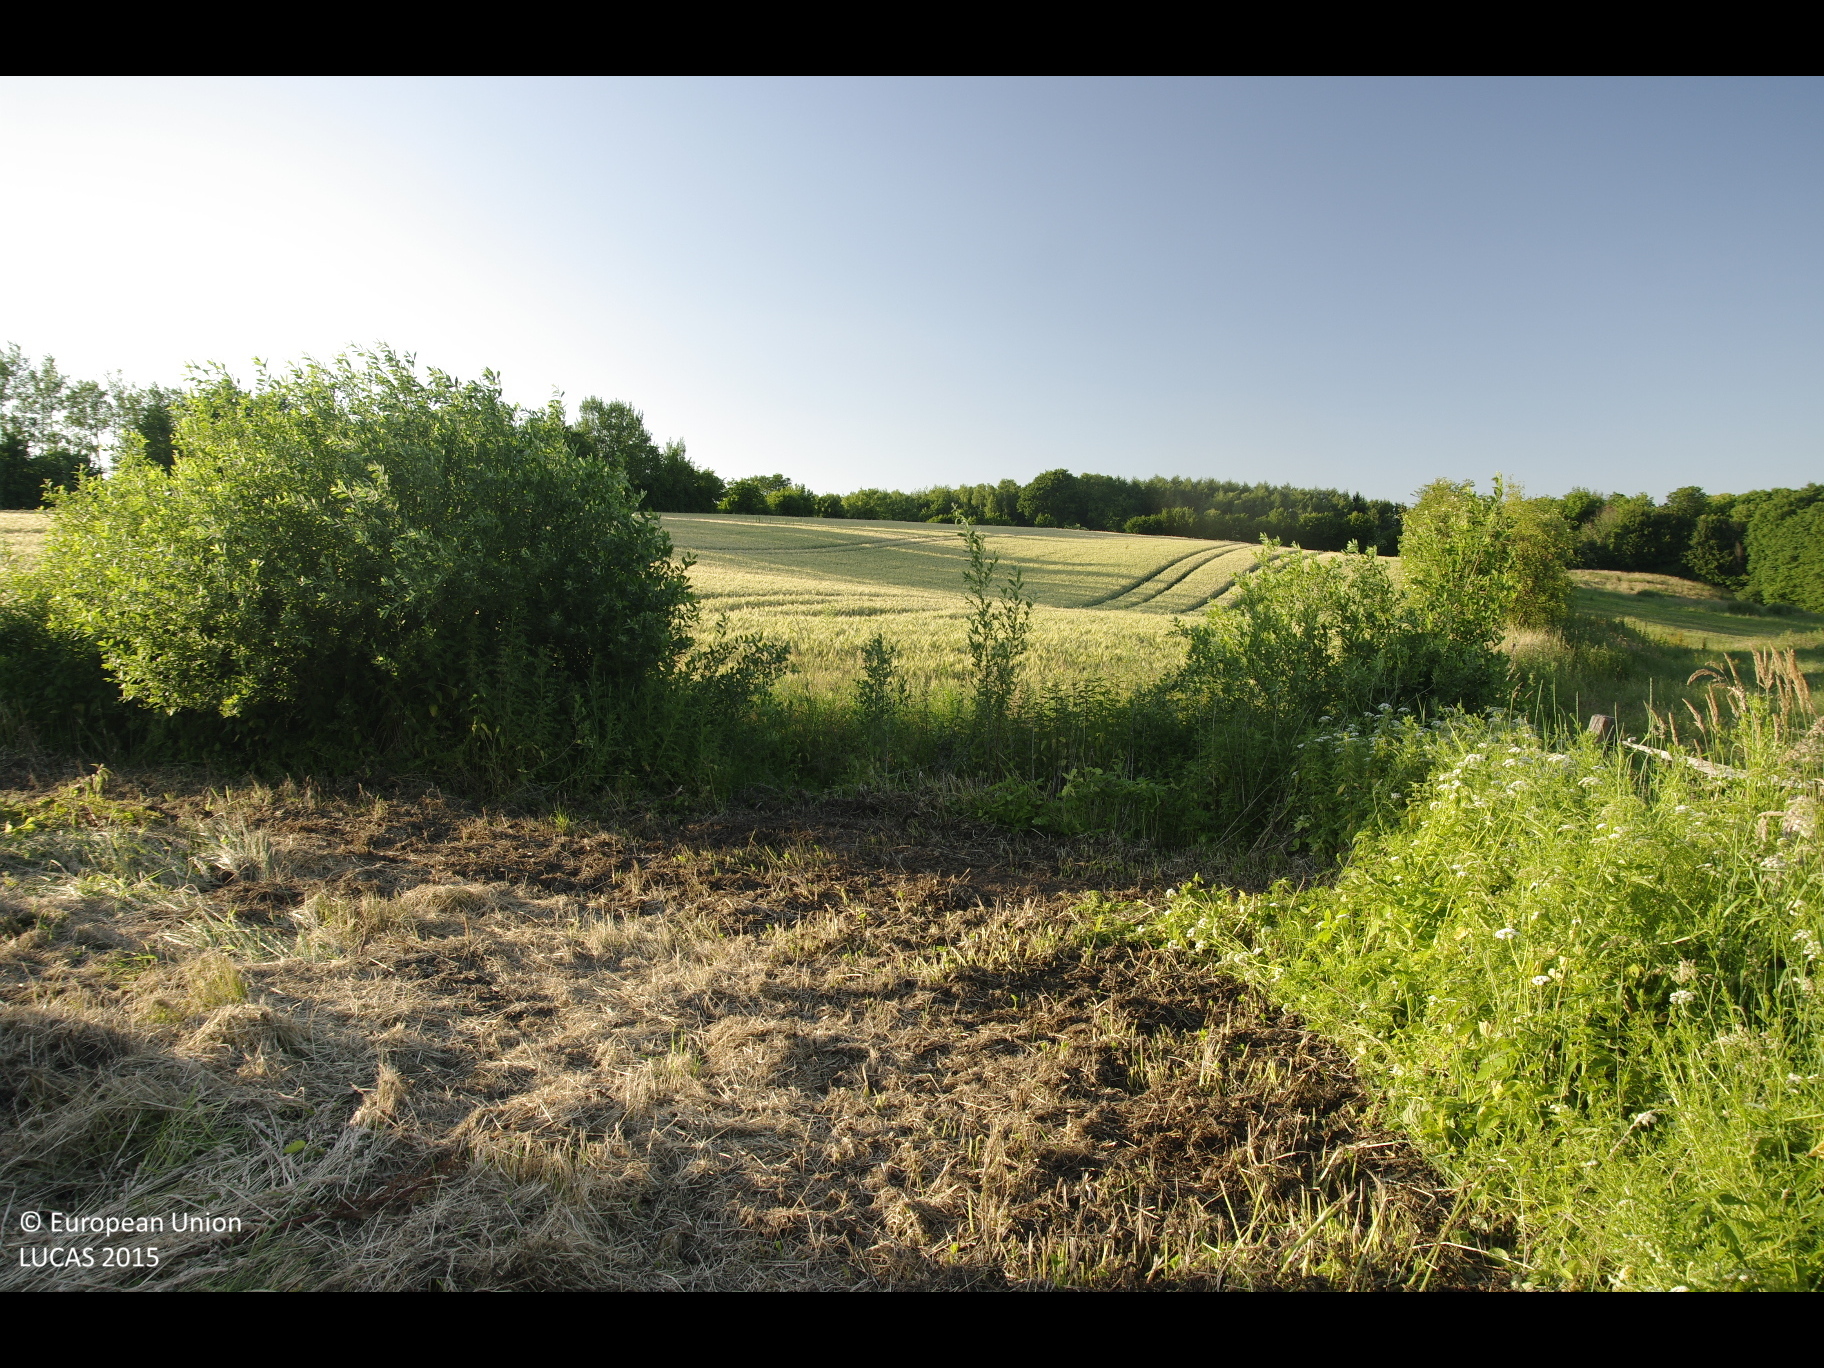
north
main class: Grassland
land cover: Grassland without tree/shrub cover
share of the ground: > 75 %
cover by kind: herbaceous plants 100 %
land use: Agriculture (excluding fallow land and kitchen gardens)
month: June
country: DE
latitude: 53.7059
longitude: 10.6208
